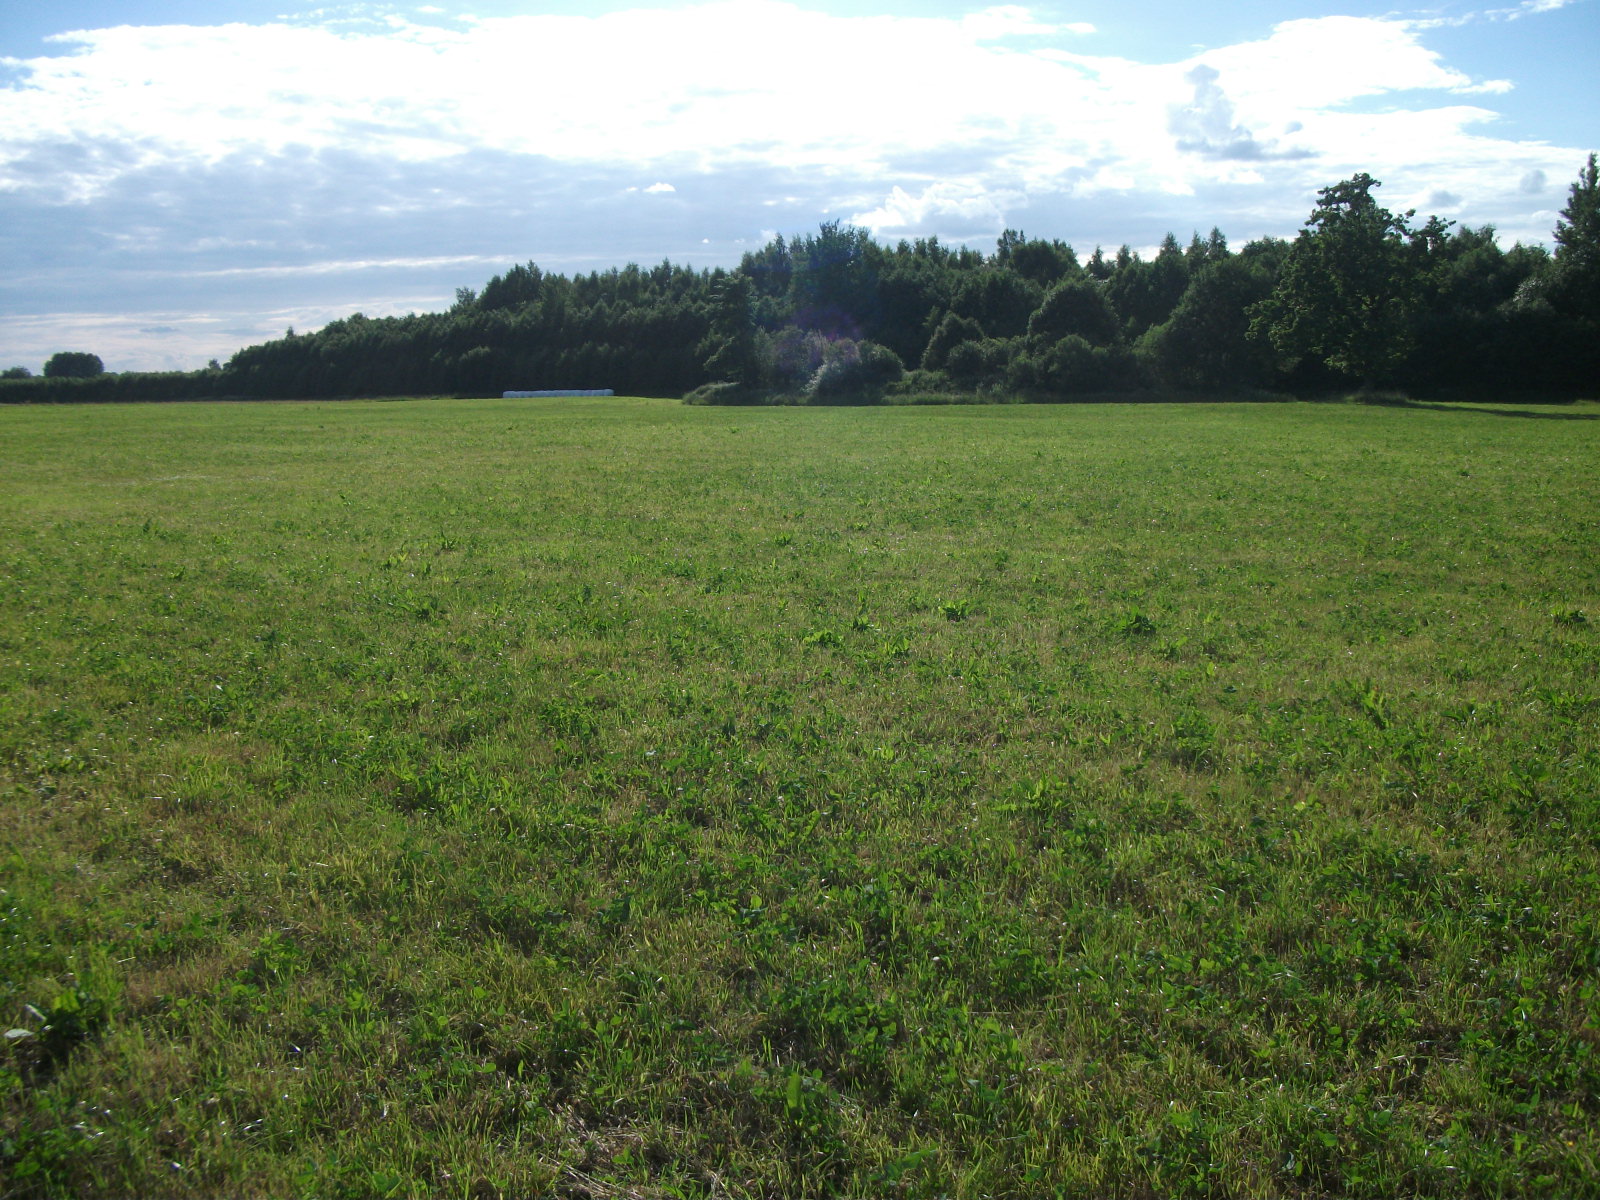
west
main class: Grassland
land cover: Grassland without tree/shrub cover
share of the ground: > 75 %
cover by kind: herbaceous plants 100 %
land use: Agriculture (excluding fallow land and kitchen gardens)
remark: Harvested field
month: June
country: LV
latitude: 56.9926
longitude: 26.5911
